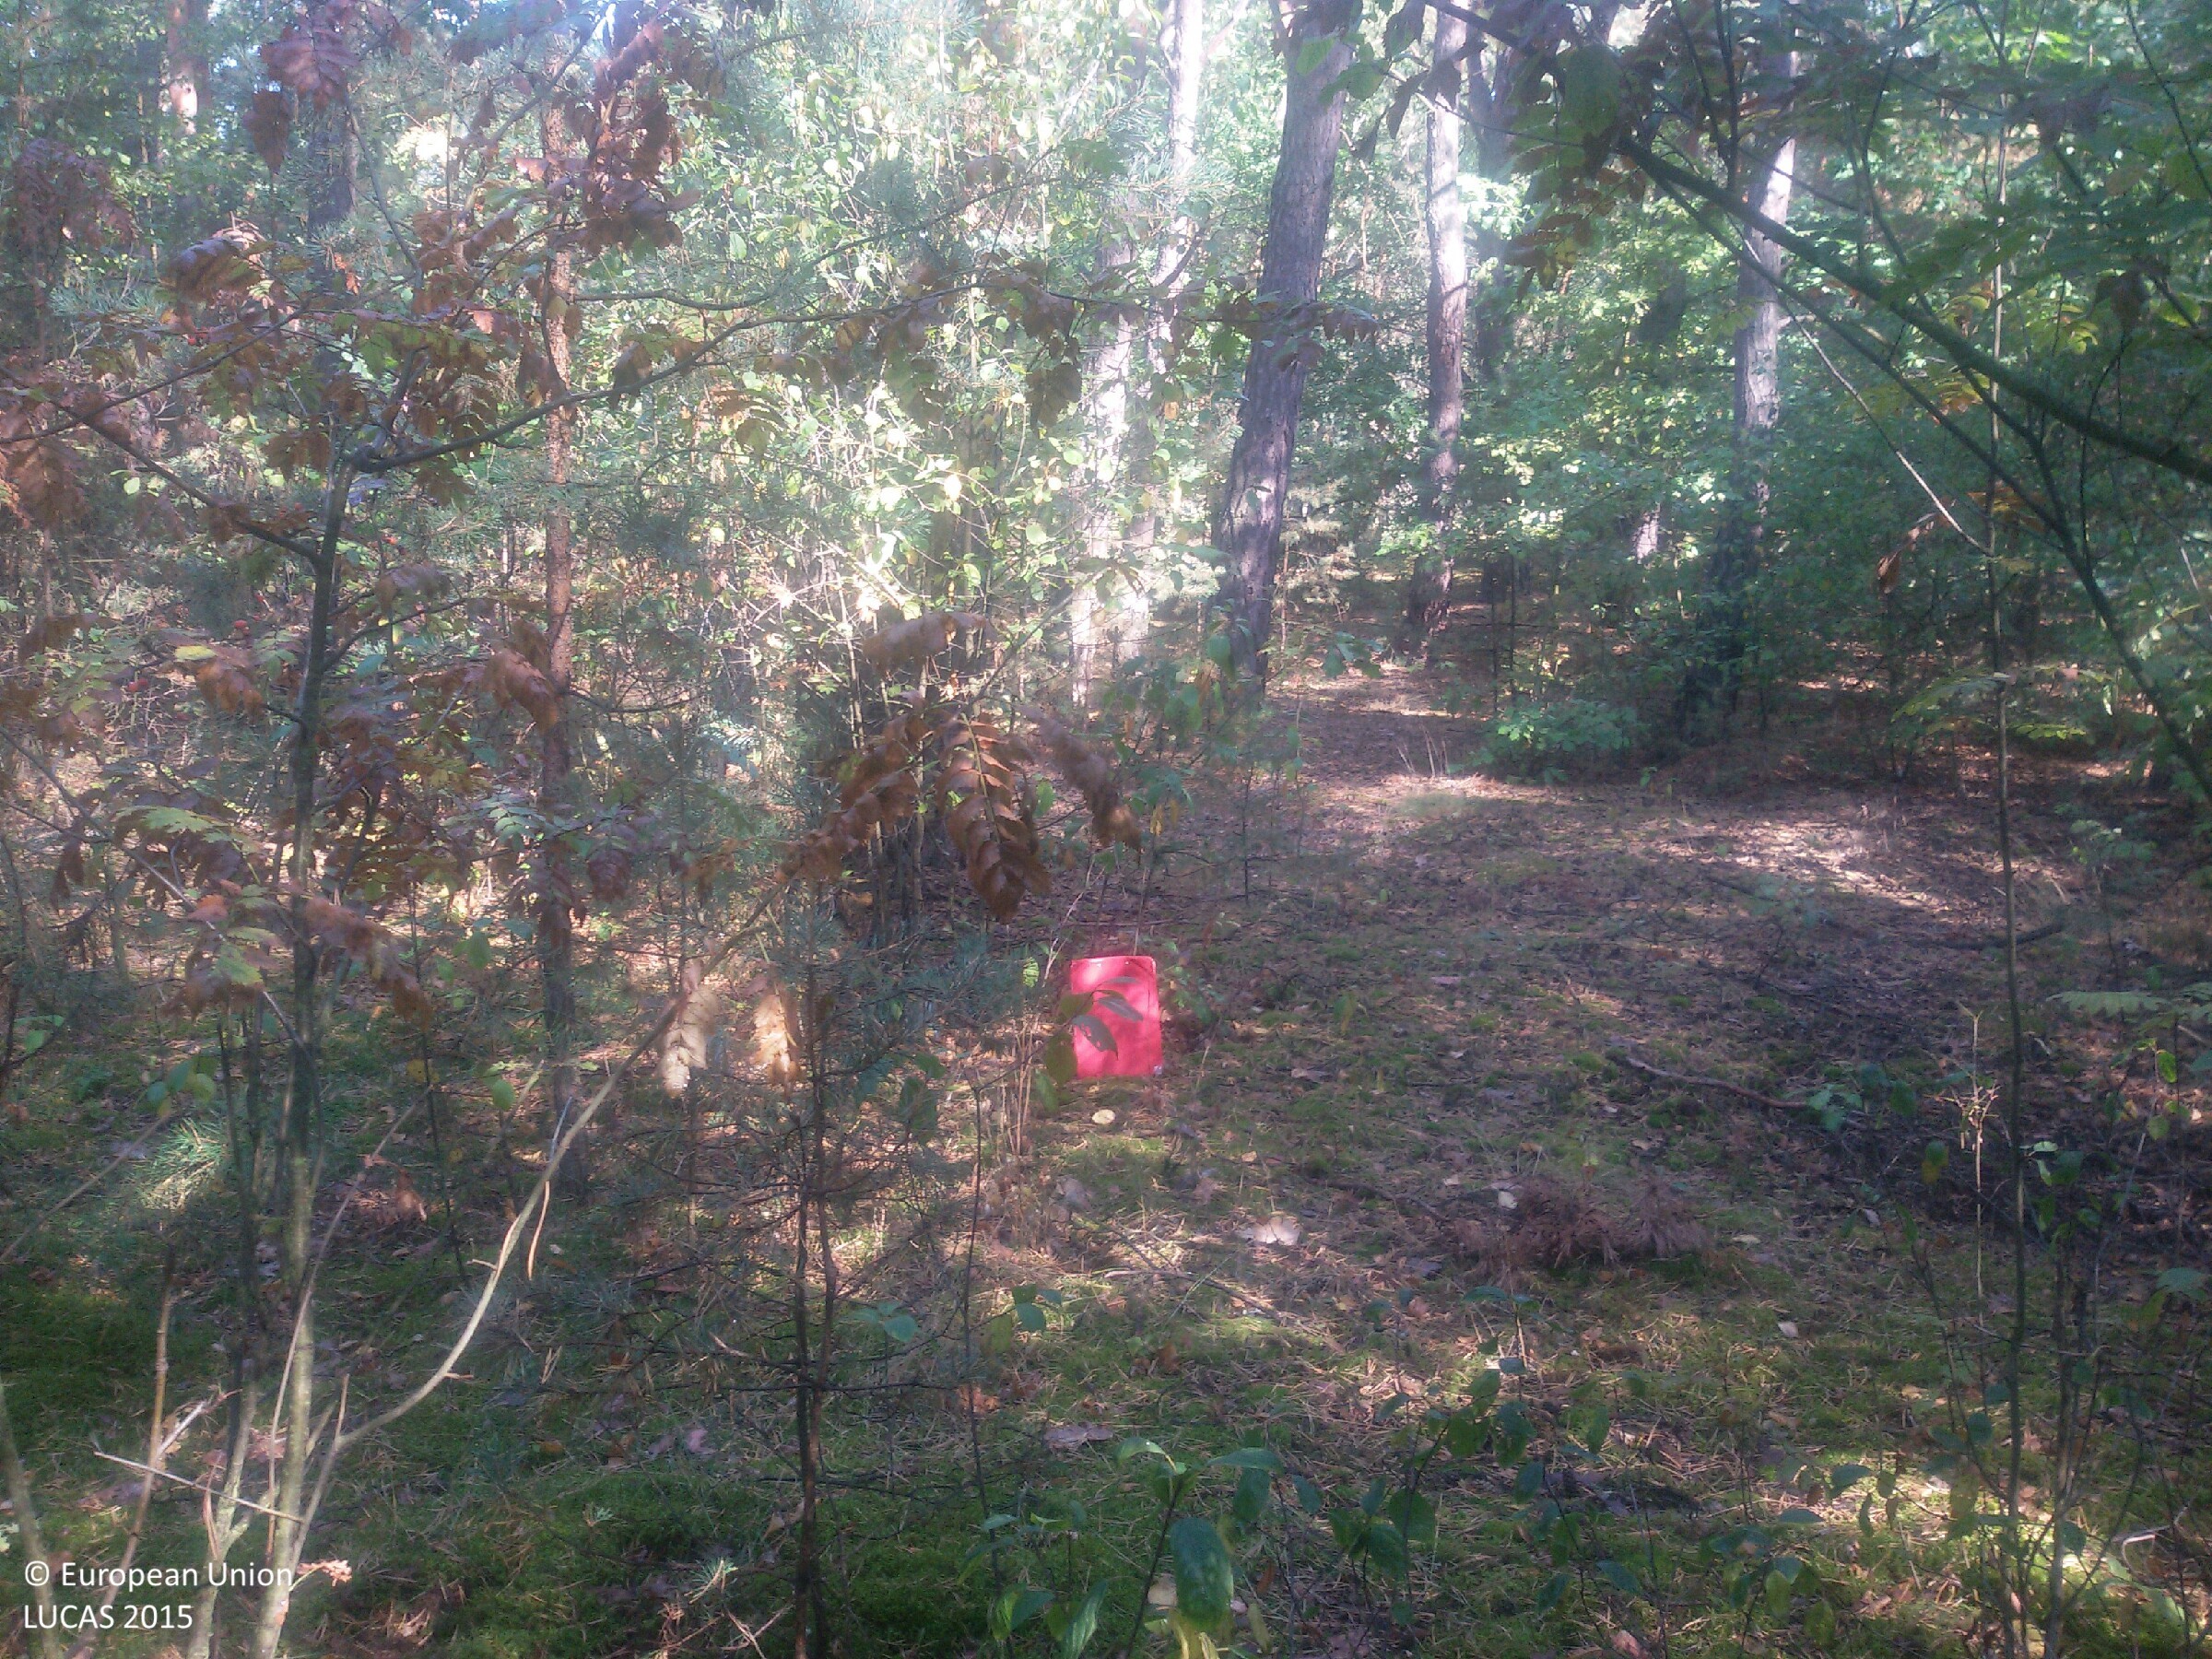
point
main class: Woodland
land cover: Pine dominated coniferous woodland
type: hemiboreal forest and nemoral coniferous forest and mixed broadleaved-coniferous forest
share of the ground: > 75 %
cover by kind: coniferous forest trees 80 %, herbaceous plants 10 %, broadleaved forest trees 5 %, shrubs 5 %
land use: Forestry
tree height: > 5 m
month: August
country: PL
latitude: 51.4681
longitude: 20.9702
